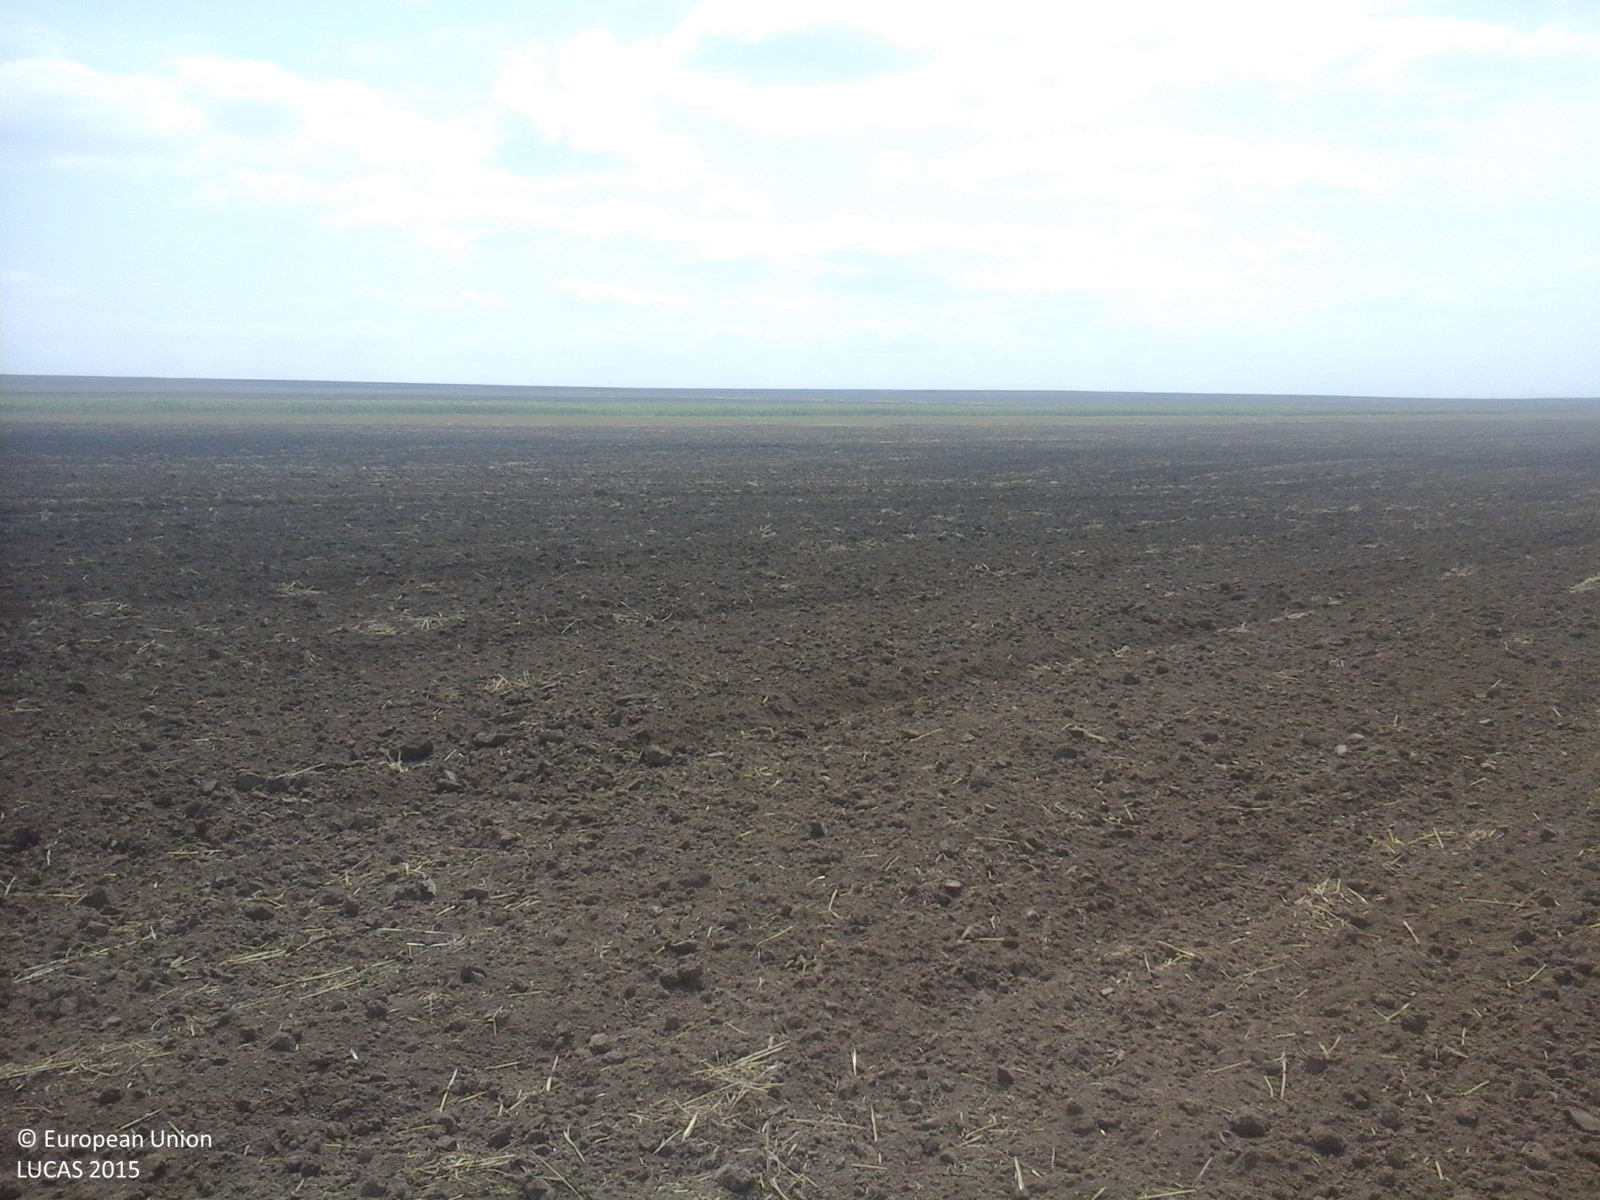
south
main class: Cropland
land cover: Common wheat
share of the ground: < 10 %
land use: Agriculture (excluding fallow land and kitchen gardens)
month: August
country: RO
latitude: 44.7248
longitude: 28.2611
